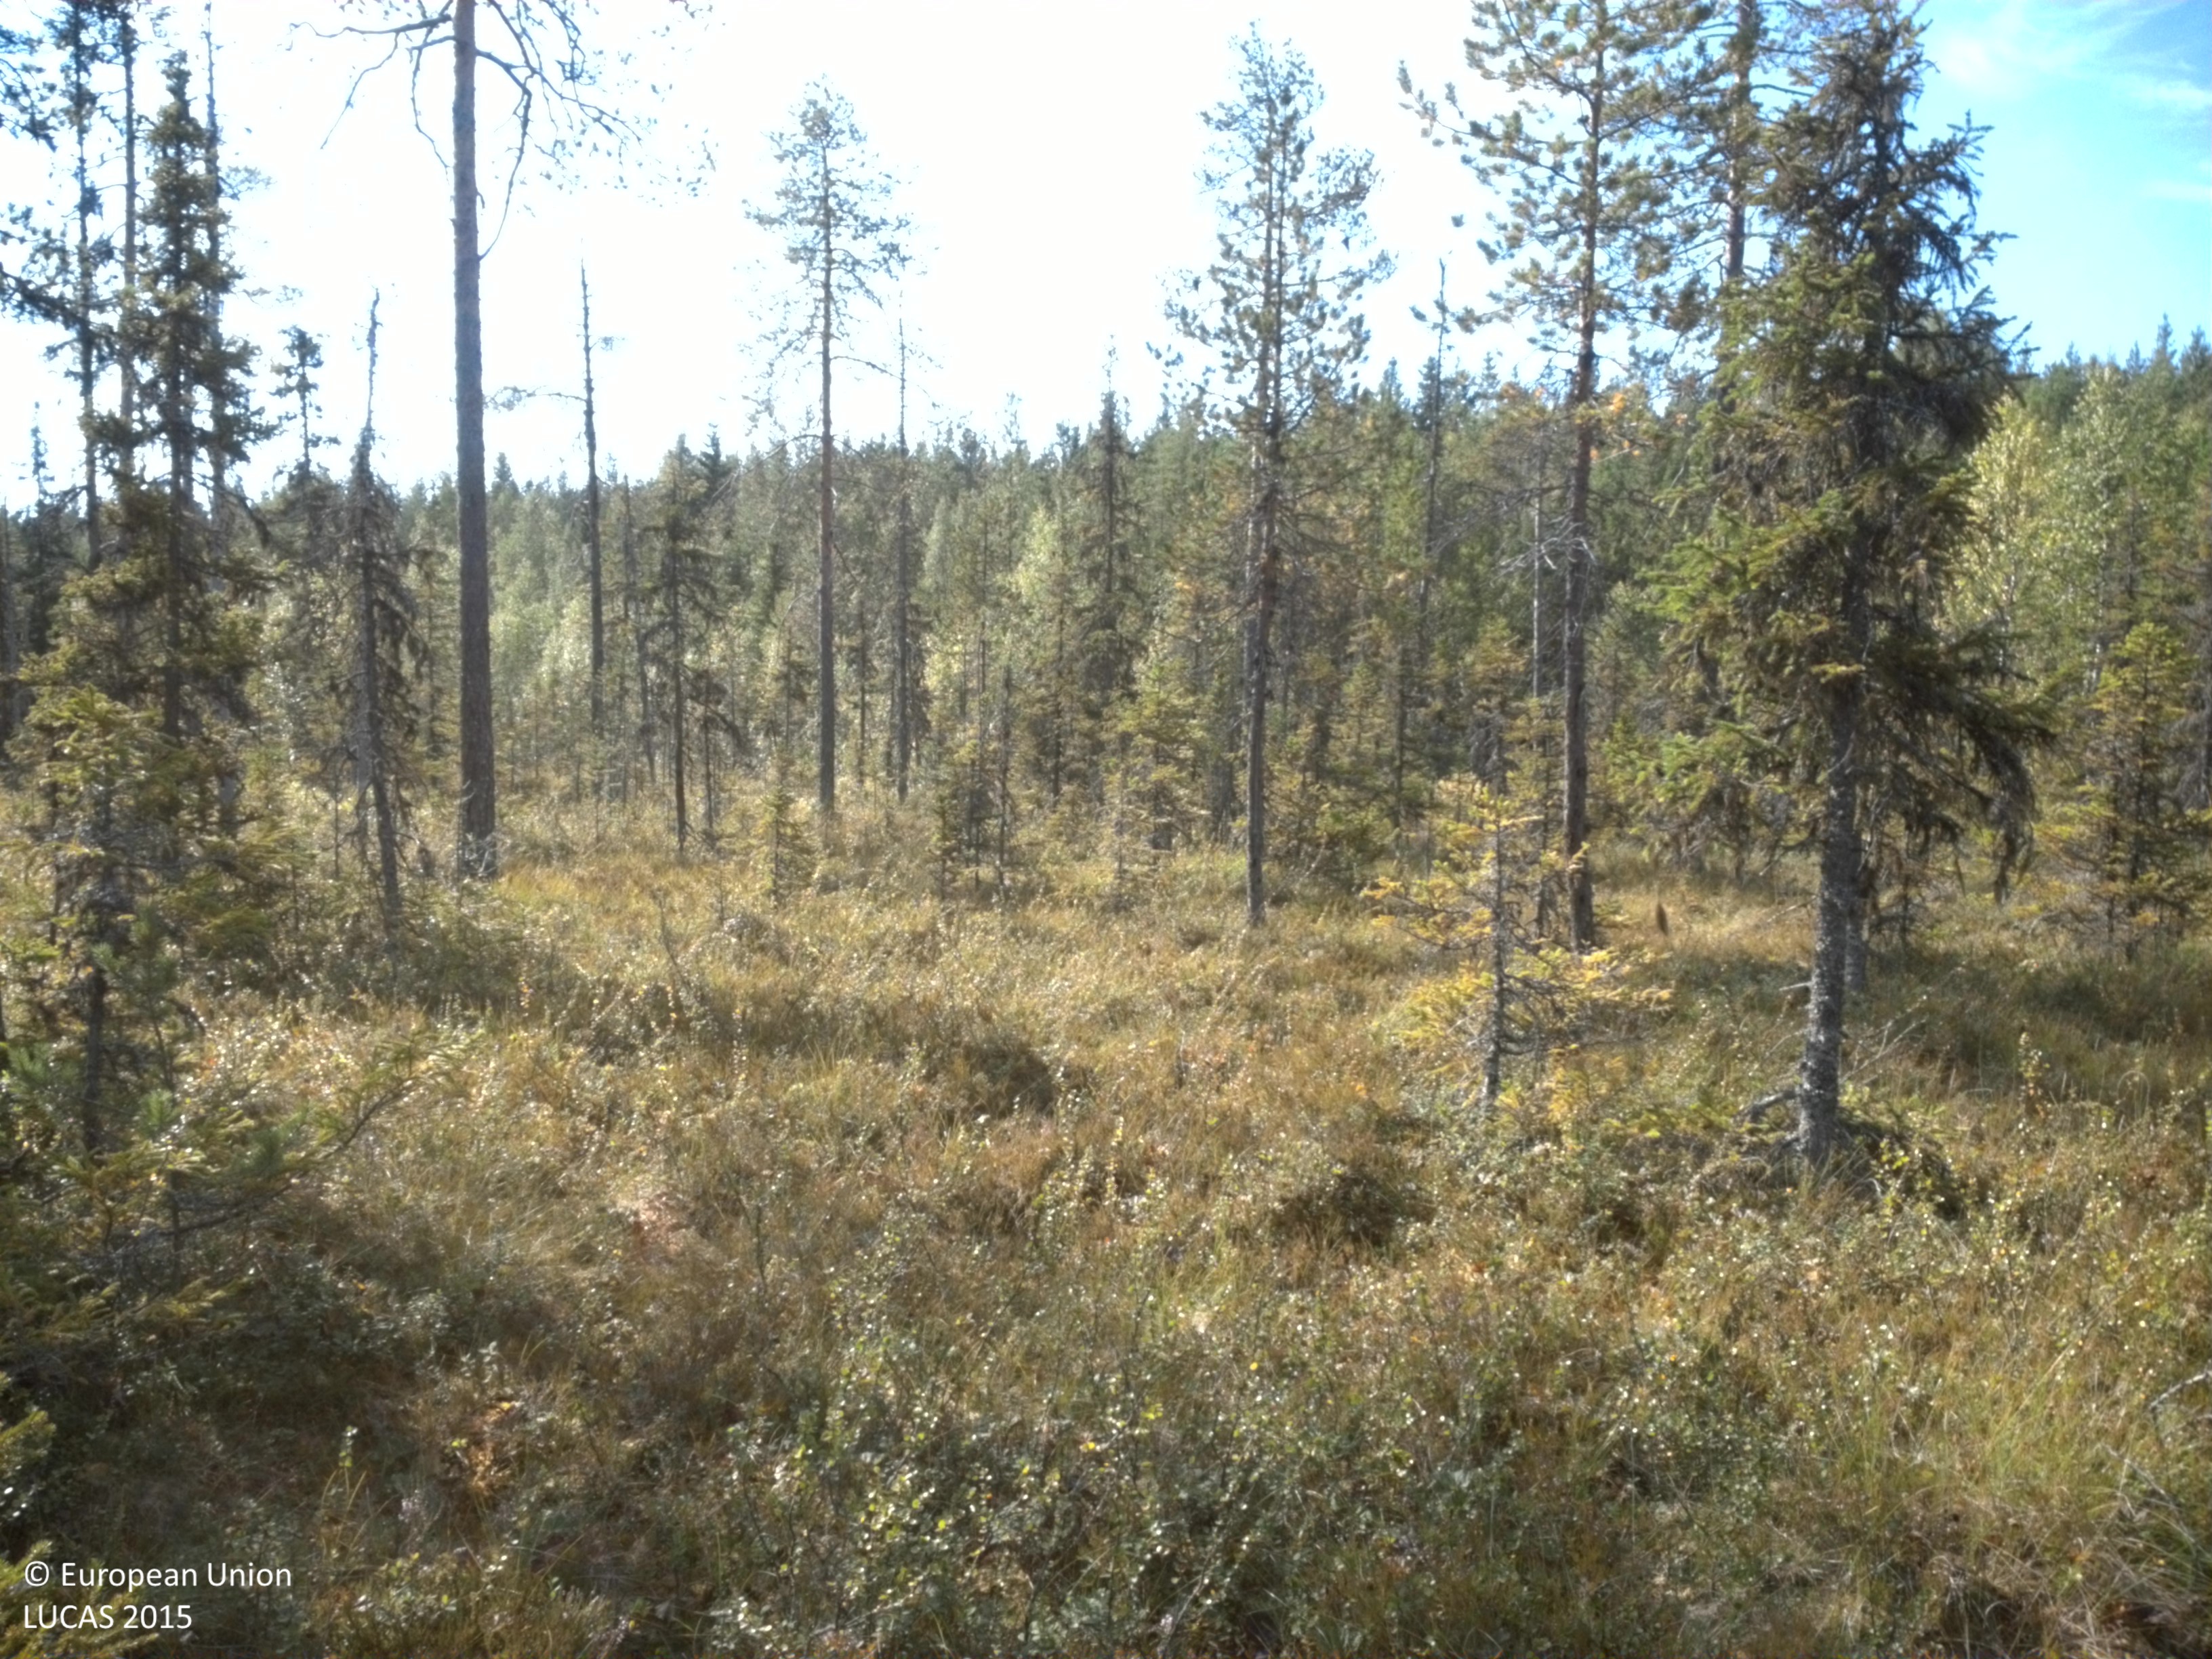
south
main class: Woodland
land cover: Spruce dominated mixed woodland
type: mire and swamp forests
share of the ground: 25 - 50 %
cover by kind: coniferous forest trees 30 %, shrubs 25 %, lichens and mosses 25 %, broadleaved forest trees 10 %, herbaceous plants 10 %
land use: Forestry
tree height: > 5 m
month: August
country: SE
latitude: 64.3530
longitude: 18.8124
